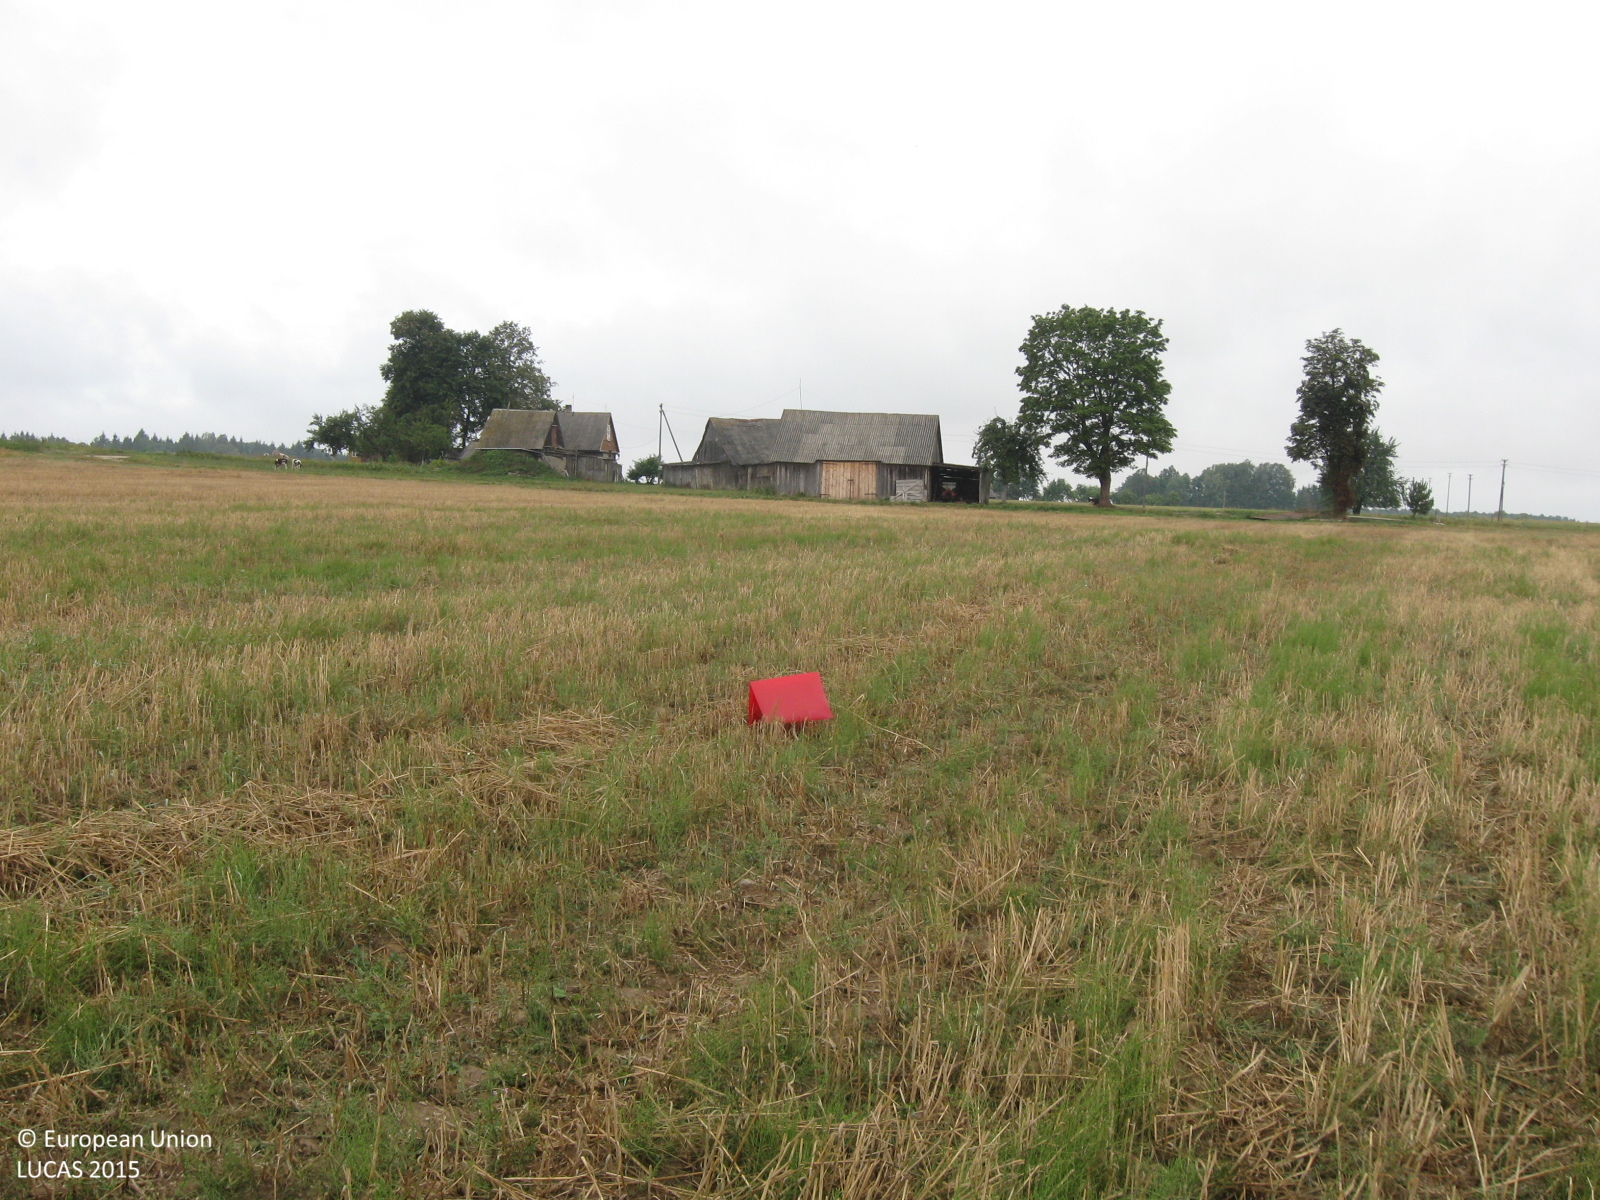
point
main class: Cropland
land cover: Common wheat
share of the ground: > 75 %
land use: Agriculture (excluding fallow land and kitchen gardens)
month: August
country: LT
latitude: 55.3656
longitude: 23.2806
